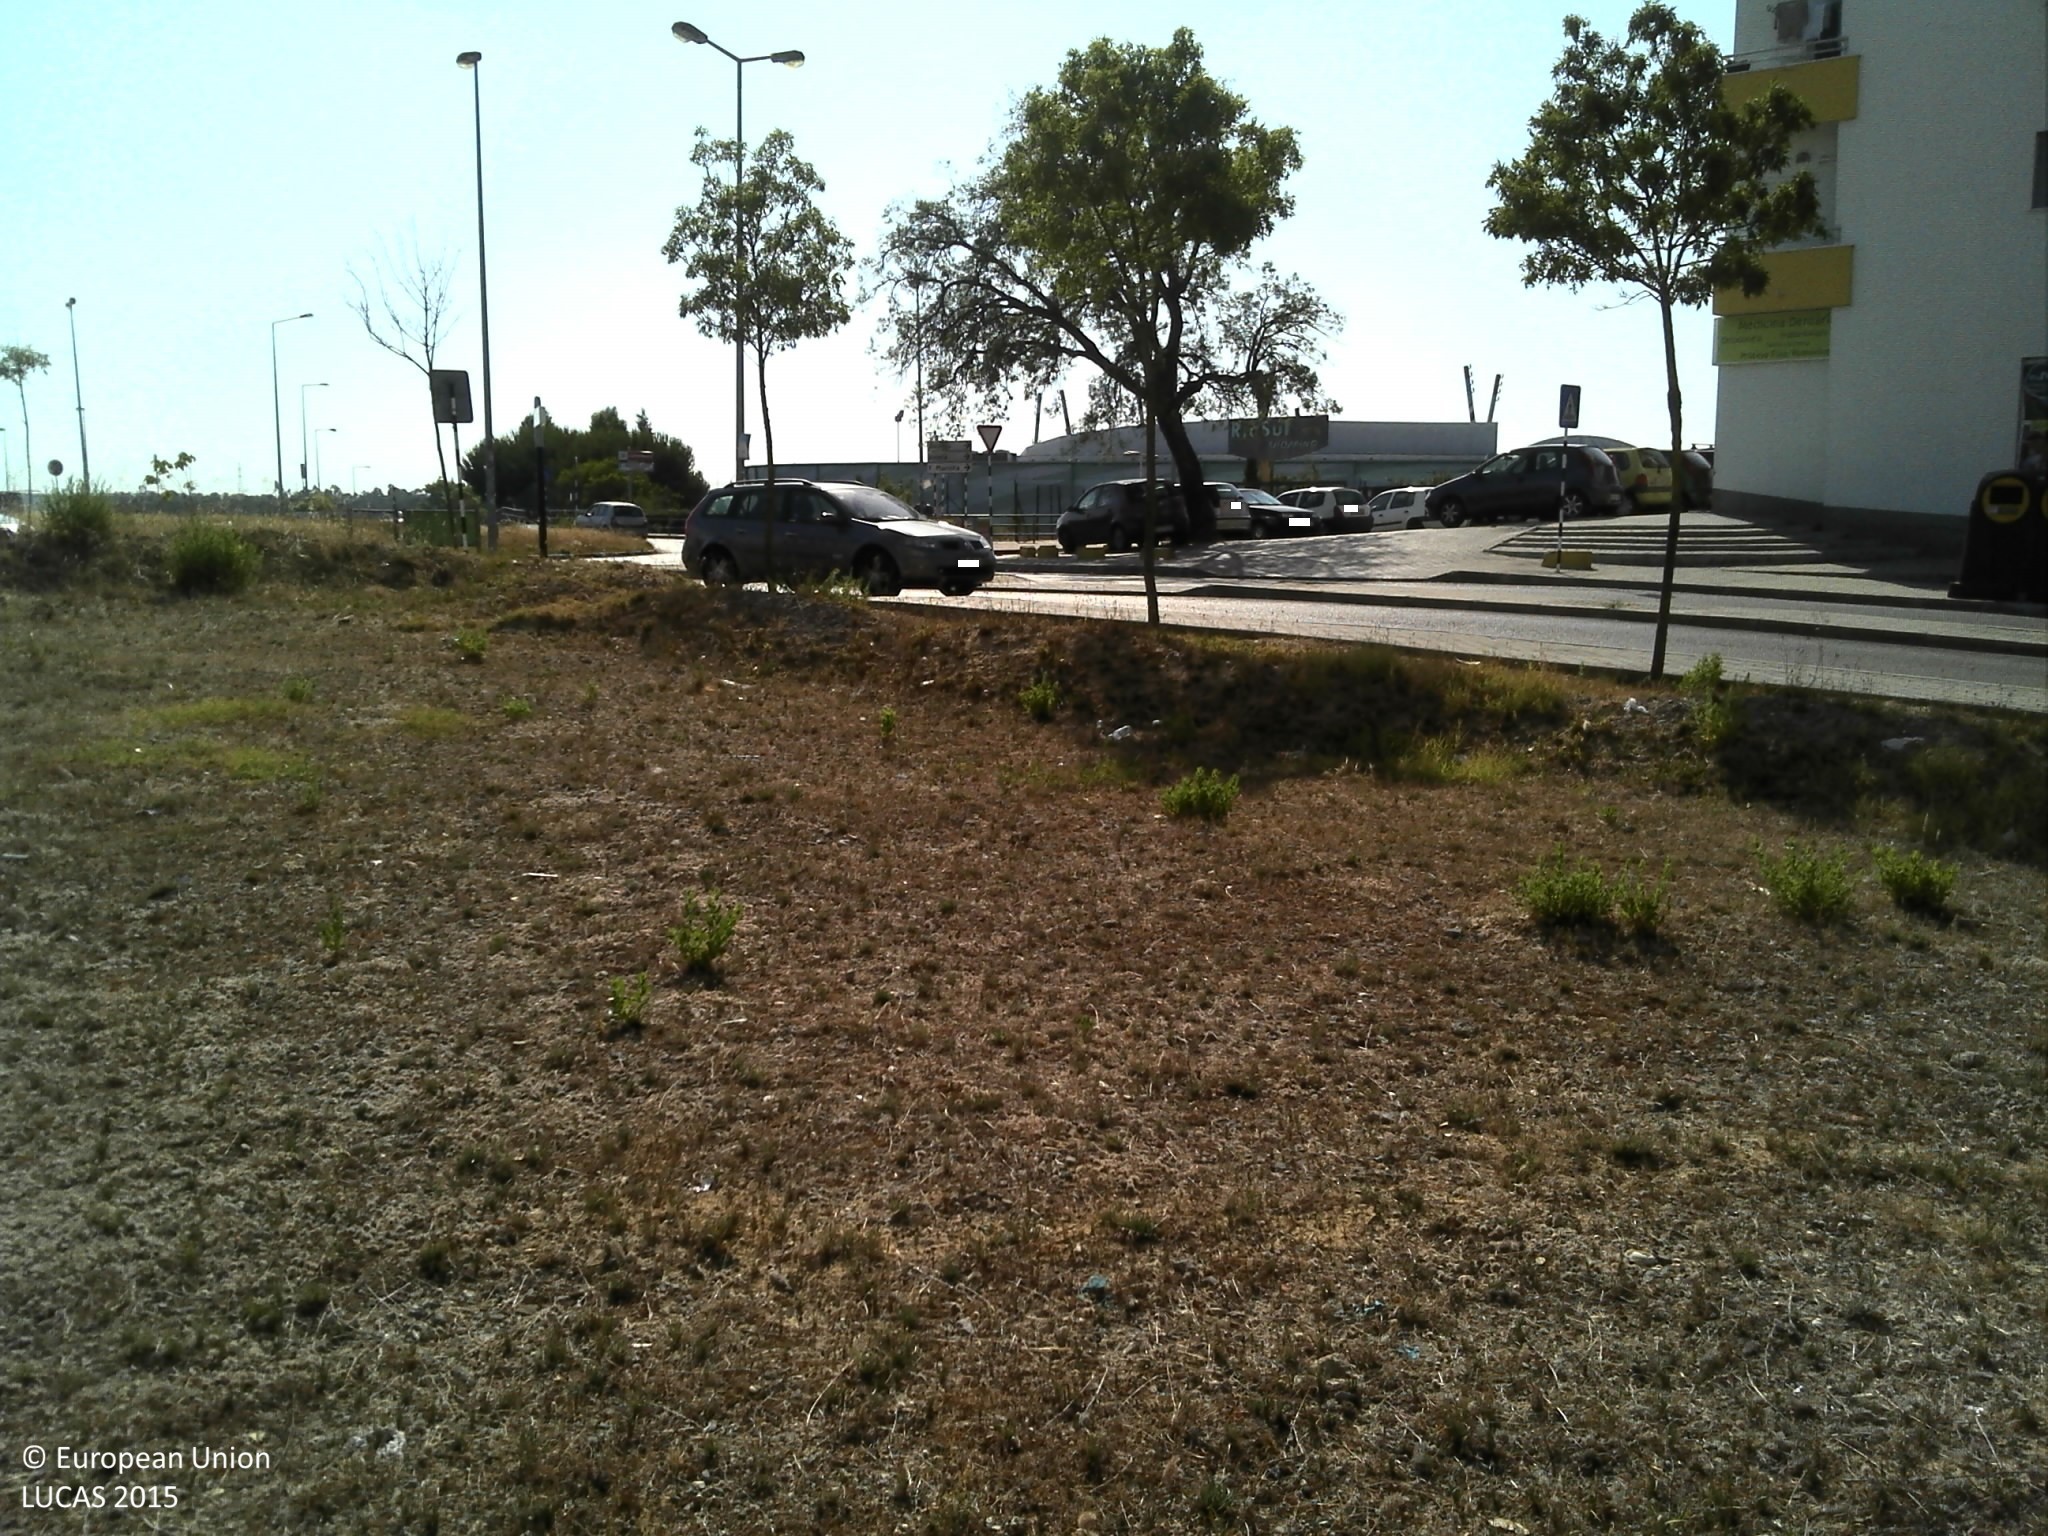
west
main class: Grassland
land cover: Grassland with sparse tree/shrub cover
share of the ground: 25 - 50 %
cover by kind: herbaceous plants 40 %, unconsolidated bare surface 35 %, broadleaved forest trees 5 %
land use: Residential
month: June
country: PT
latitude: 38.6117
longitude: -9.1011
